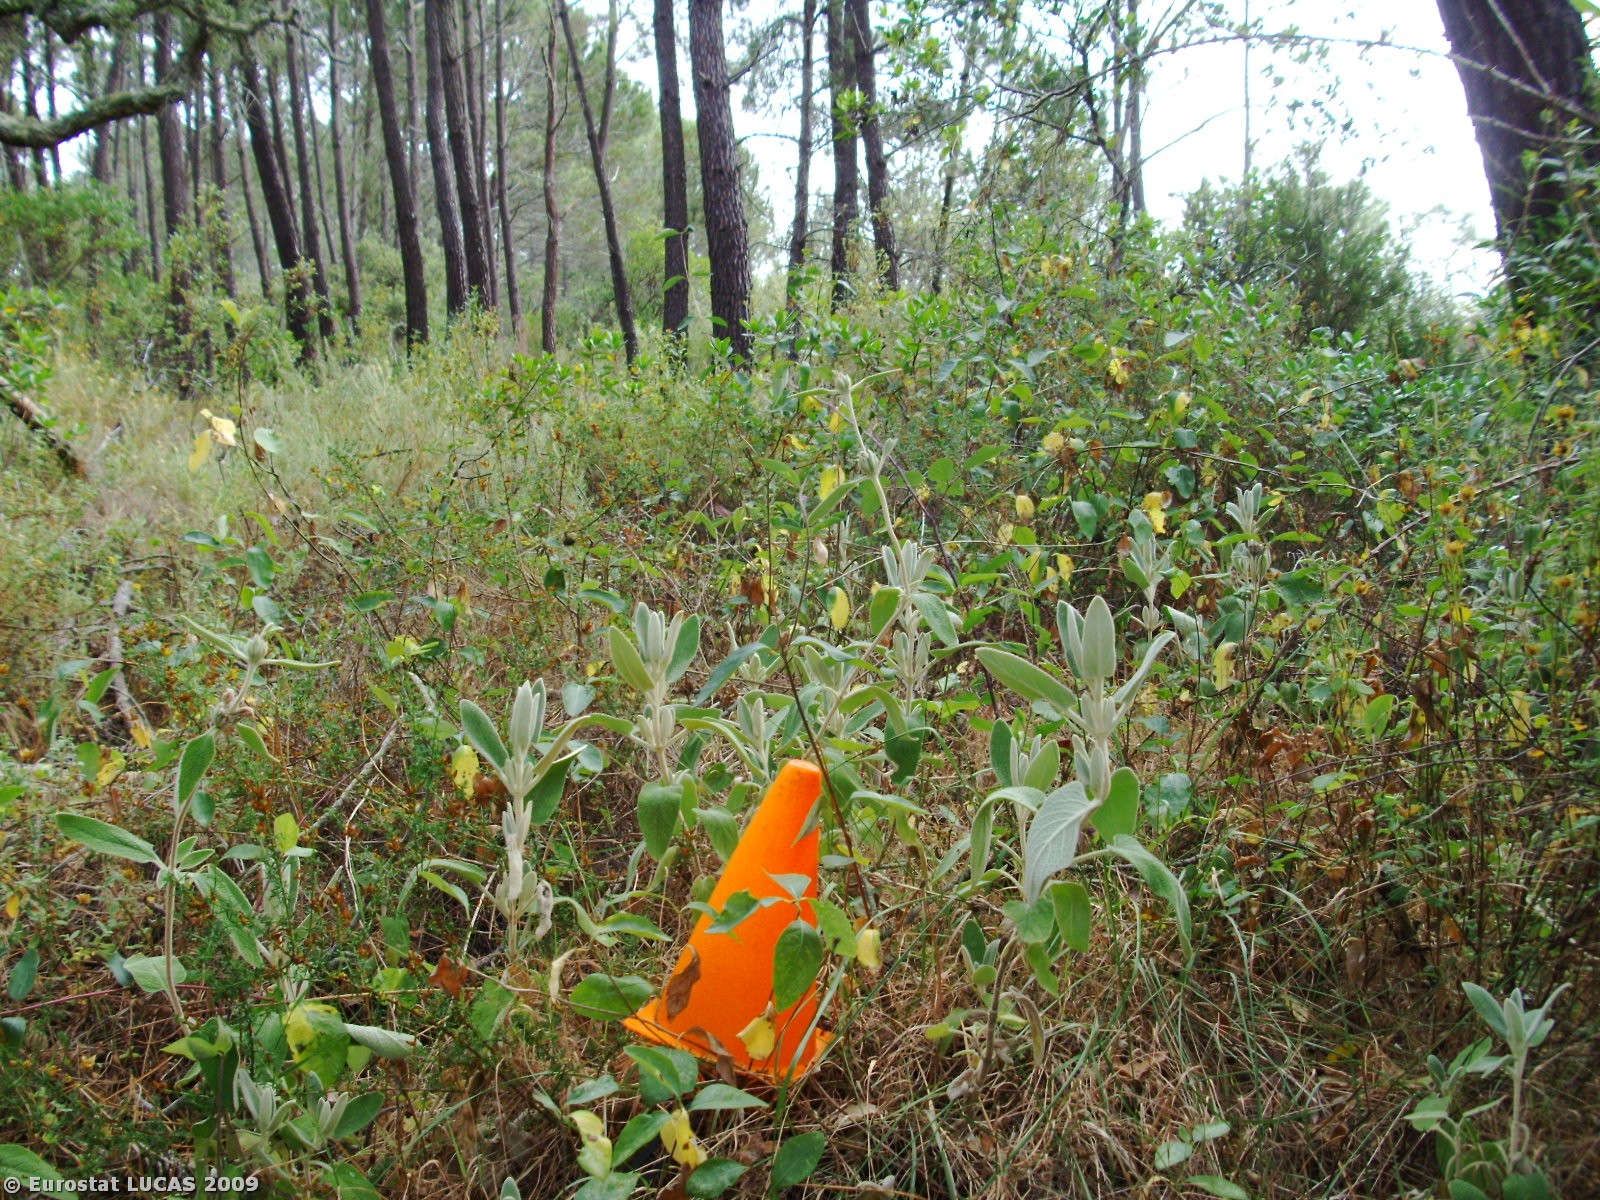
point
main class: Woodland
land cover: Coniferous woodland
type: coniferous forest of the mediterranean region
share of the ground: 25 - 50 %
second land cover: Shrubland with sparse tree cover
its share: 50 - 75 %
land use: Forestry
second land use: Nature reserves
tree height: > 5 m
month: June
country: PT
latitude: 37.1214
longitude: -8.8628
